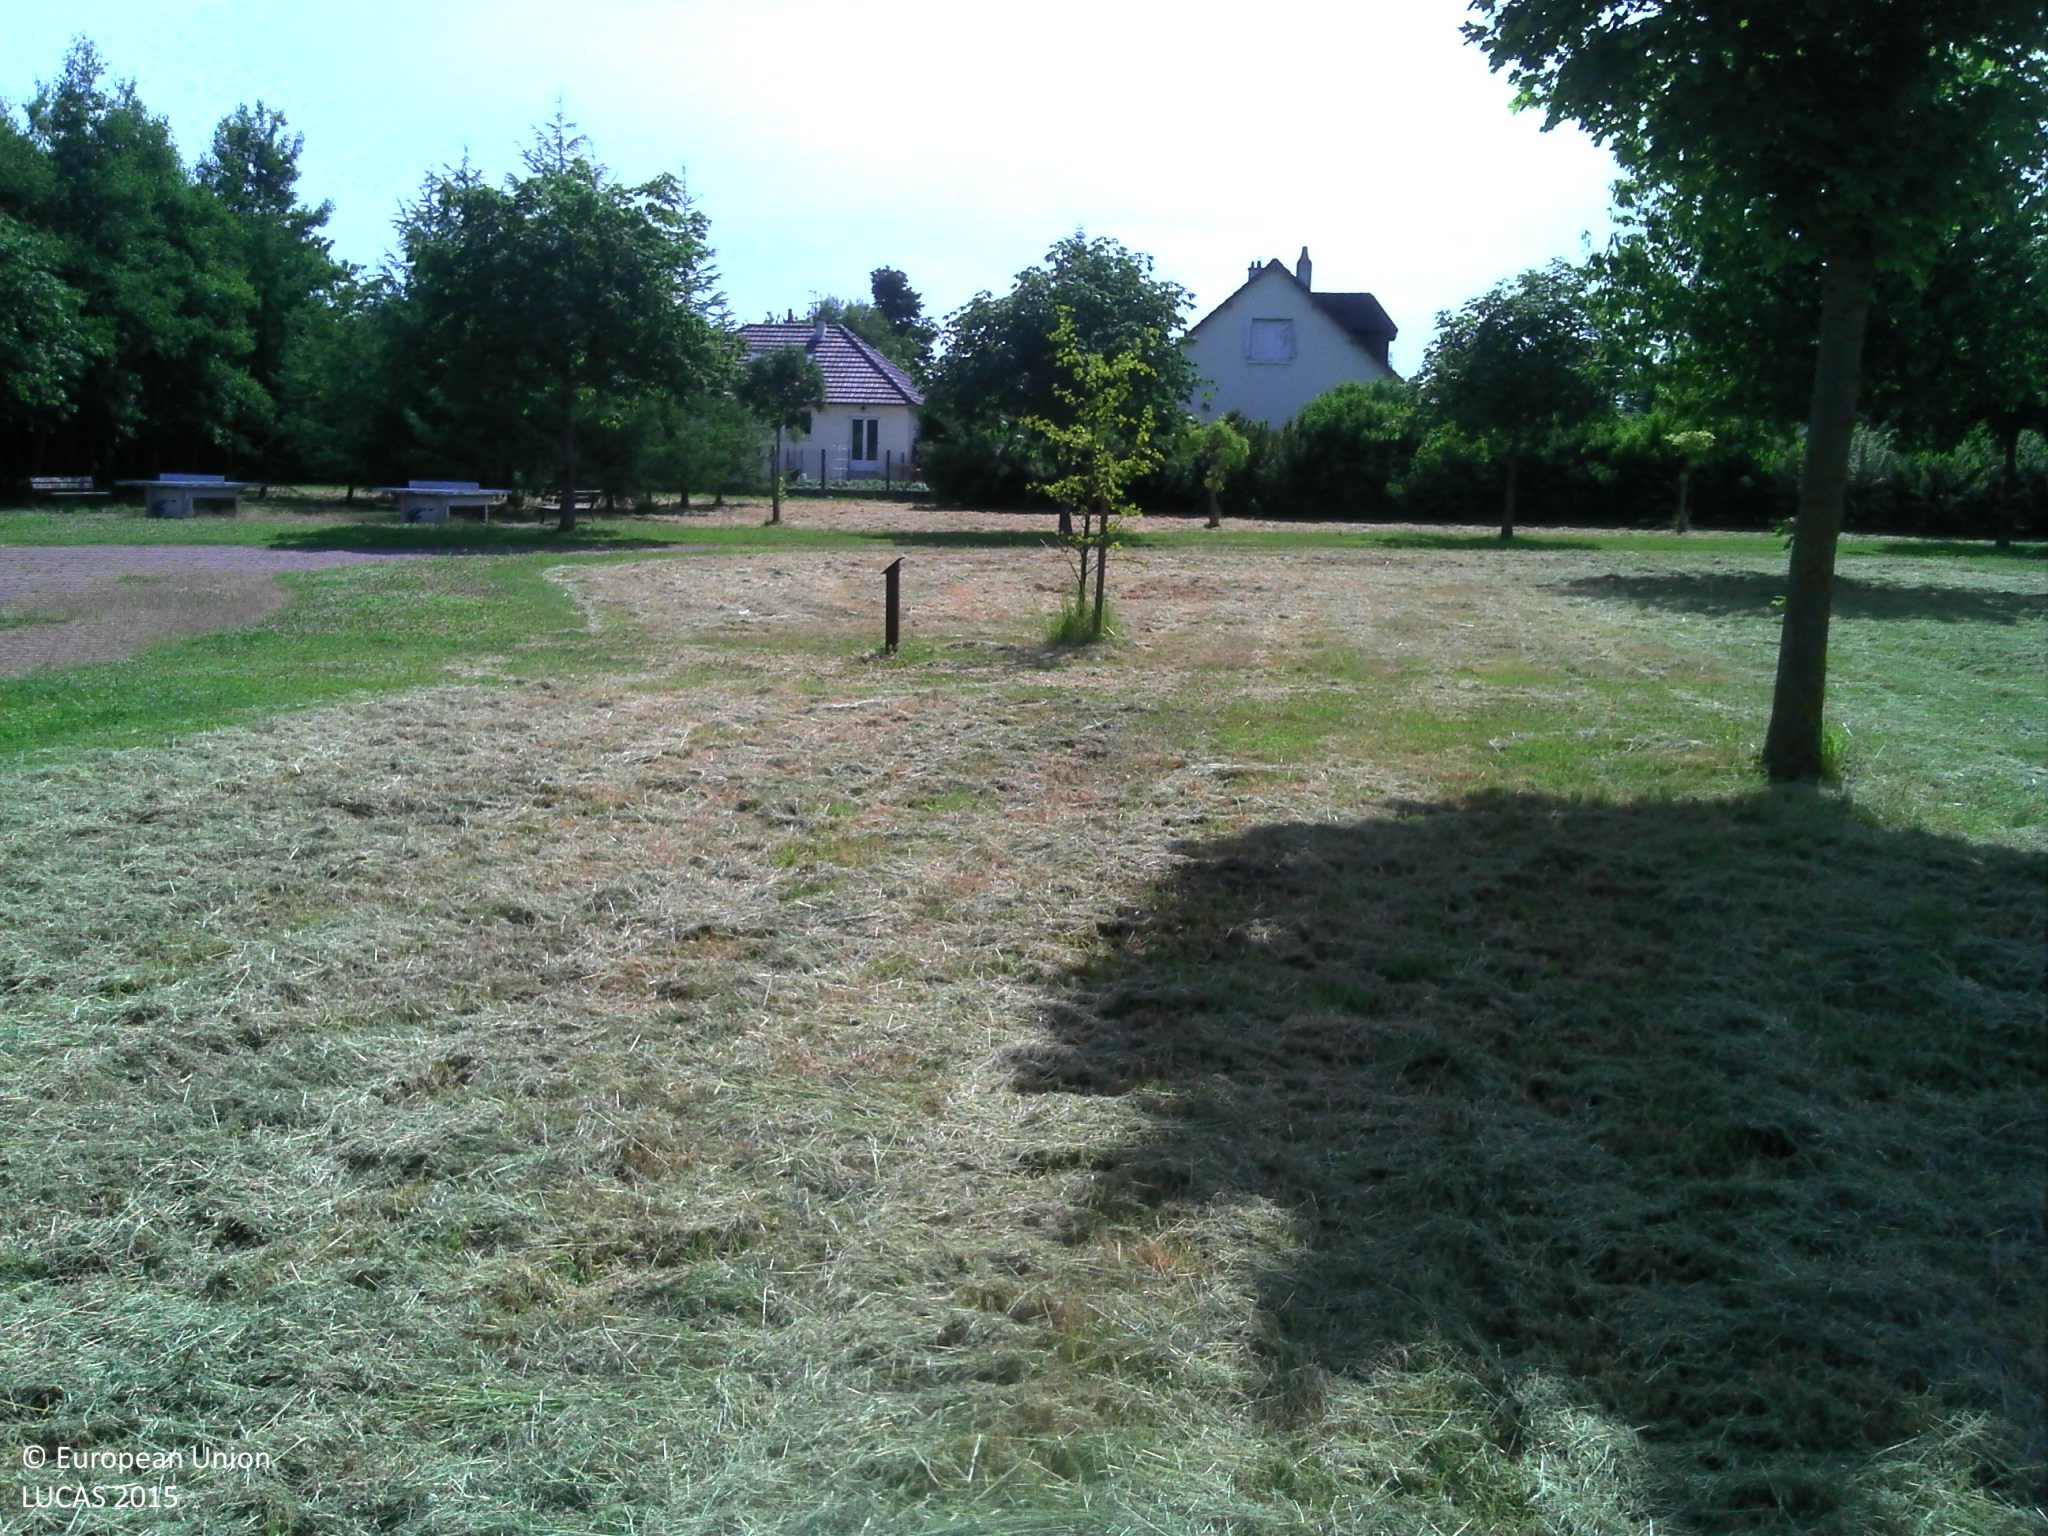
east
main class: Grassland
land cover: Grassland with sparse tree/shrub cover
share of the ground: > 75 %
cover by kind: herbaceous plants 95 %, broadleaved forest trees 5 %
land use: Amenities, museums, leisure
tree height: > 5 m
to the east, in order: Grassland with sparse tree/shrub cover; Tracks; Grassland with sparse tree/shrub cover; Artificial constructions in urban areas
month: June
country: FR
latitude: 49.1362
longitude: -0.3002
